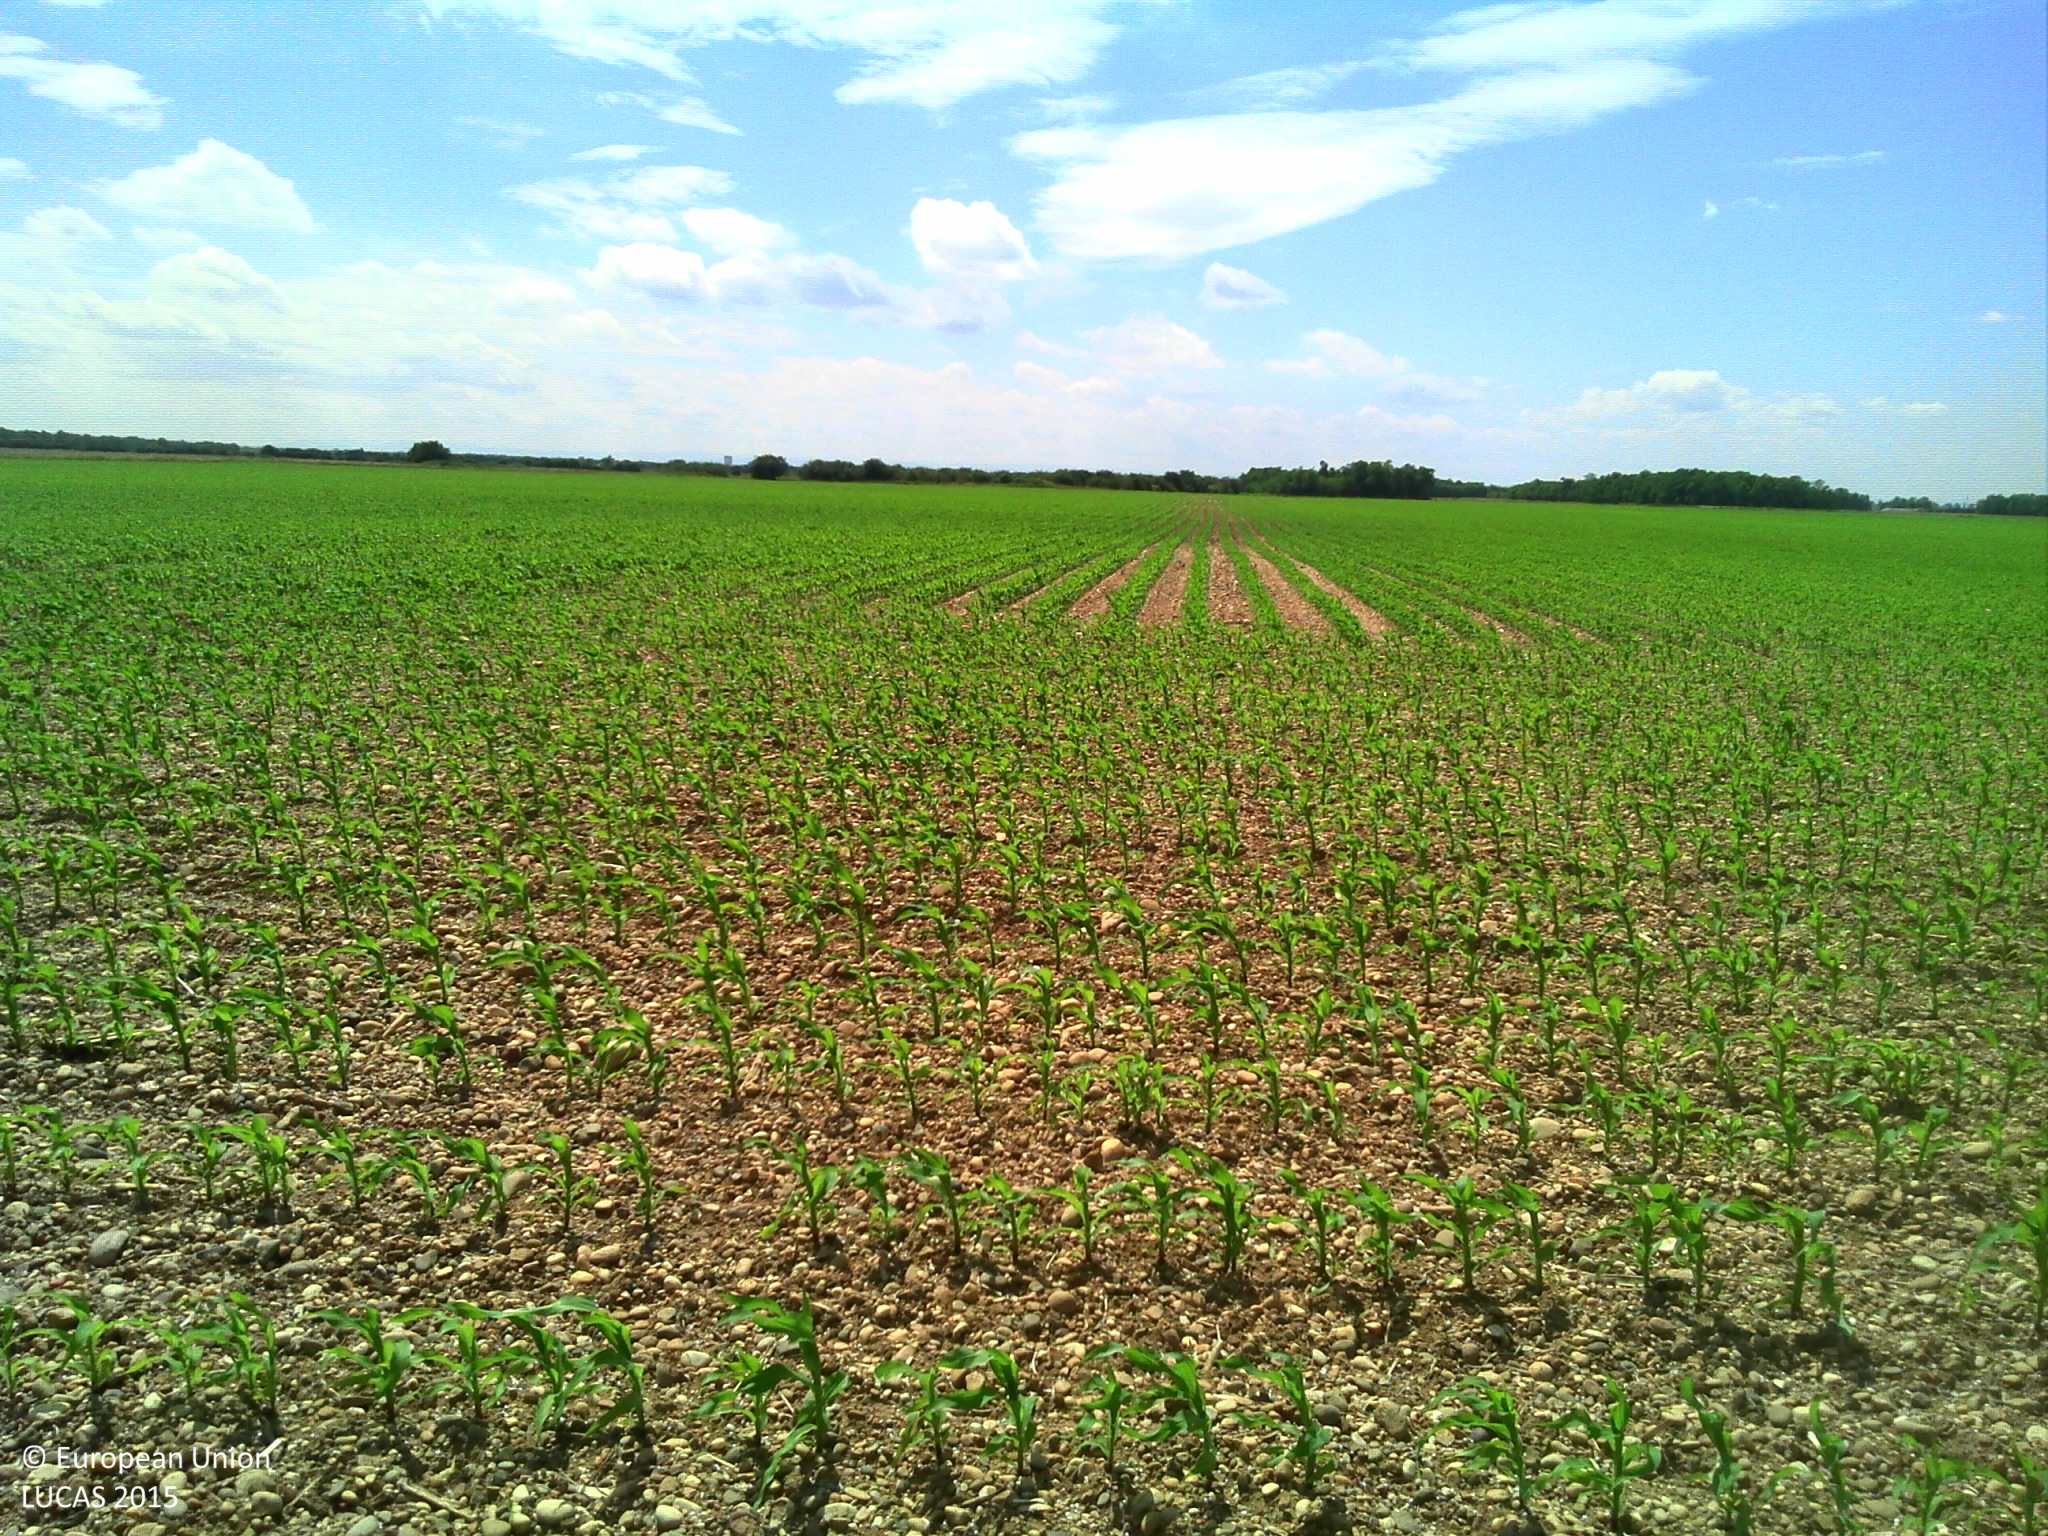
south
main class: Cropland
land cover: Maize
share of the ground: < 10 %
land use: Agriculture (excluding fallow land and kitchen gardens)
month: June
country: FR
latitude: 47.9046
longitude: 7.3926
